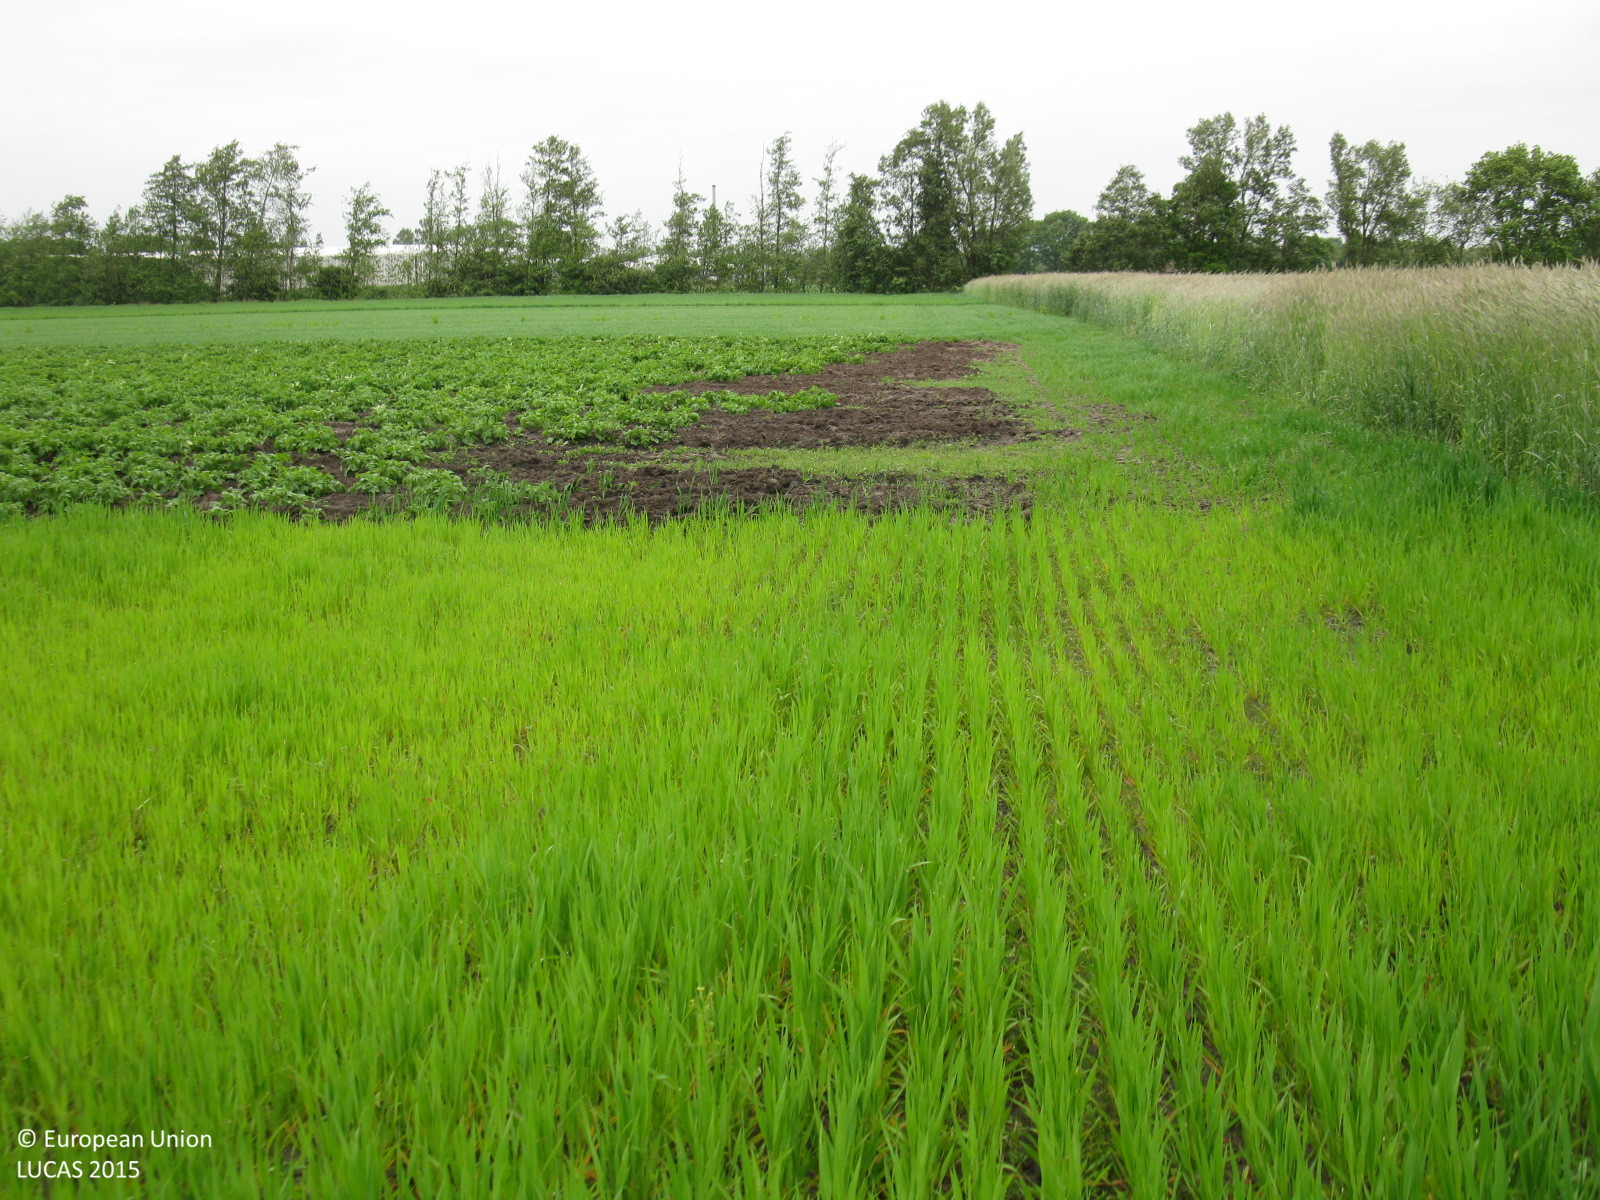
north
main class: Cropland
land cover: Oats
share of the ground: > 75 %
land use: Agriculture (excluding fallow land and kitchen gardens)
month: June
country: DE
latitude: 53.0322
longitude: 7.3910
